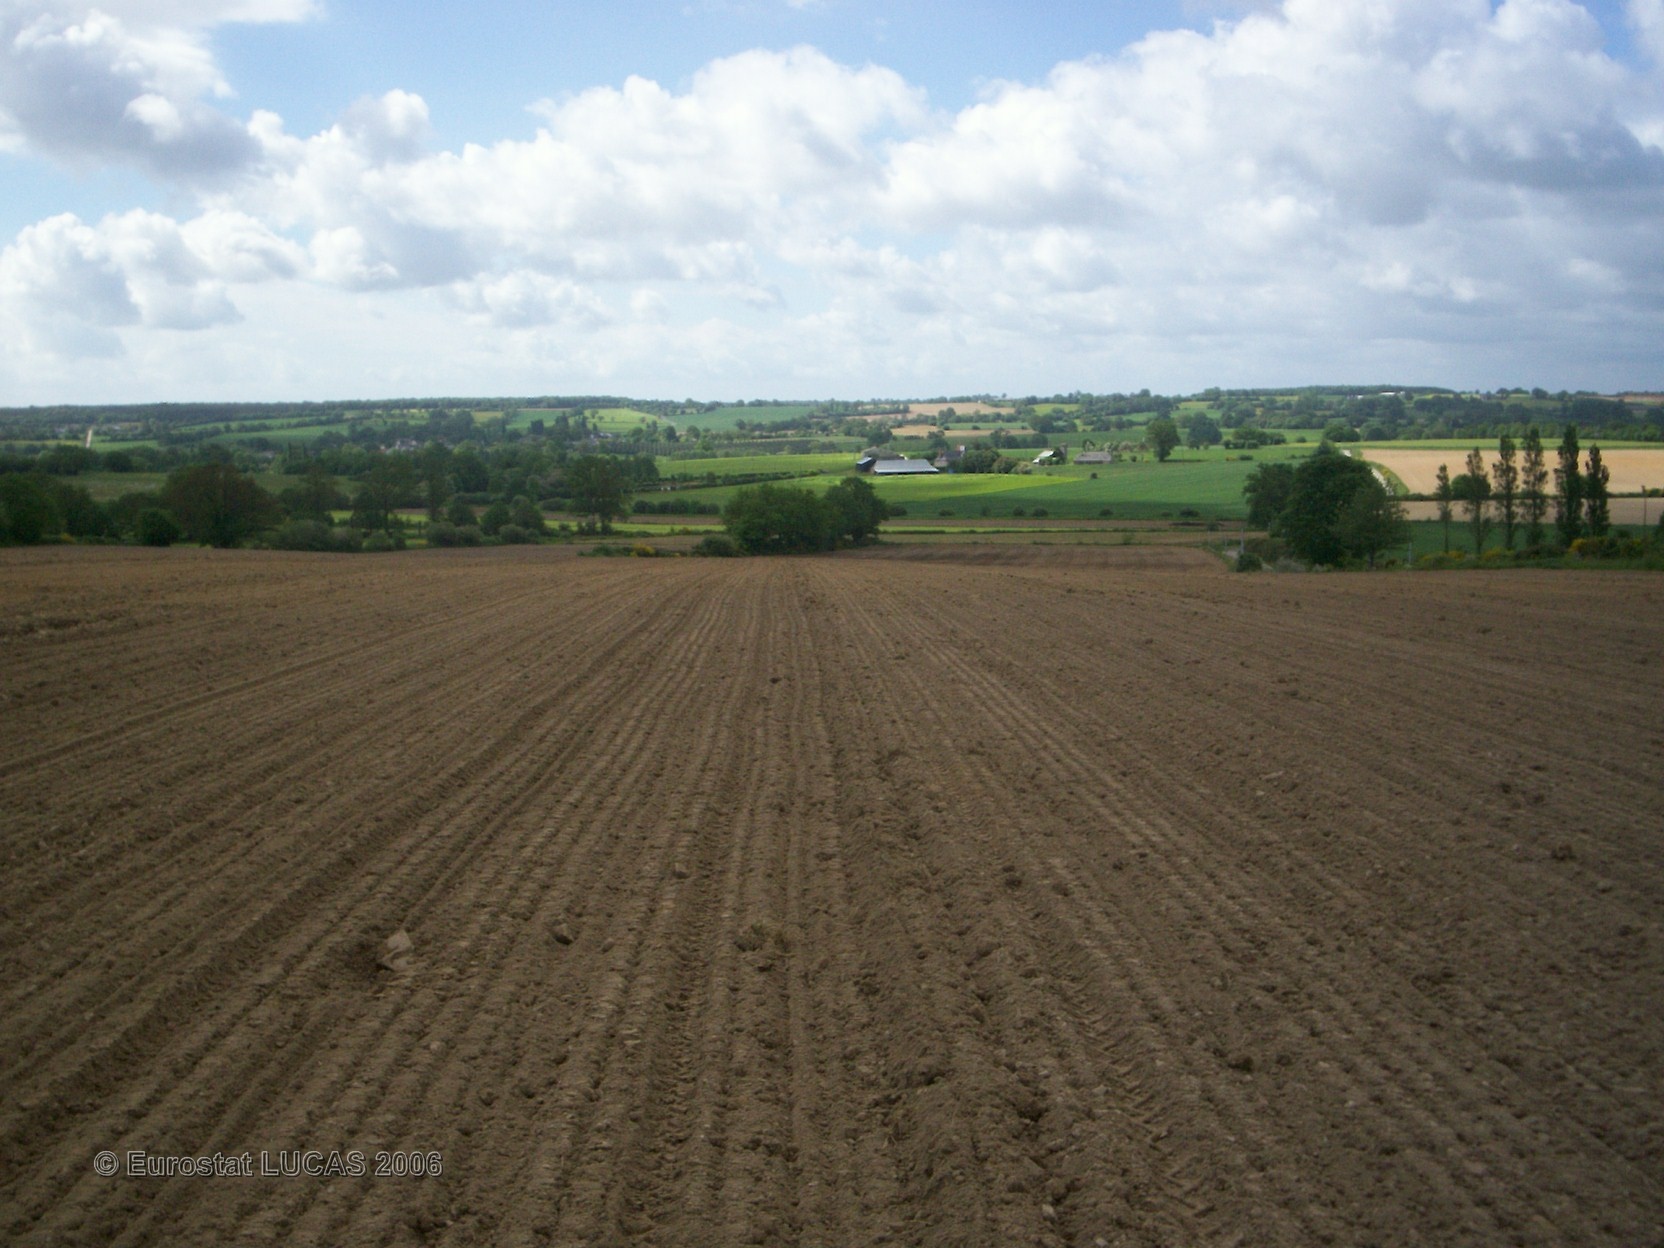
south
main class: Cropland
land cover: Maize
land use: Agriculture (excluding fallow land and kitchen gardens)
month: May
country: FR
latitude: 47.7727
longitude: -1.0744
